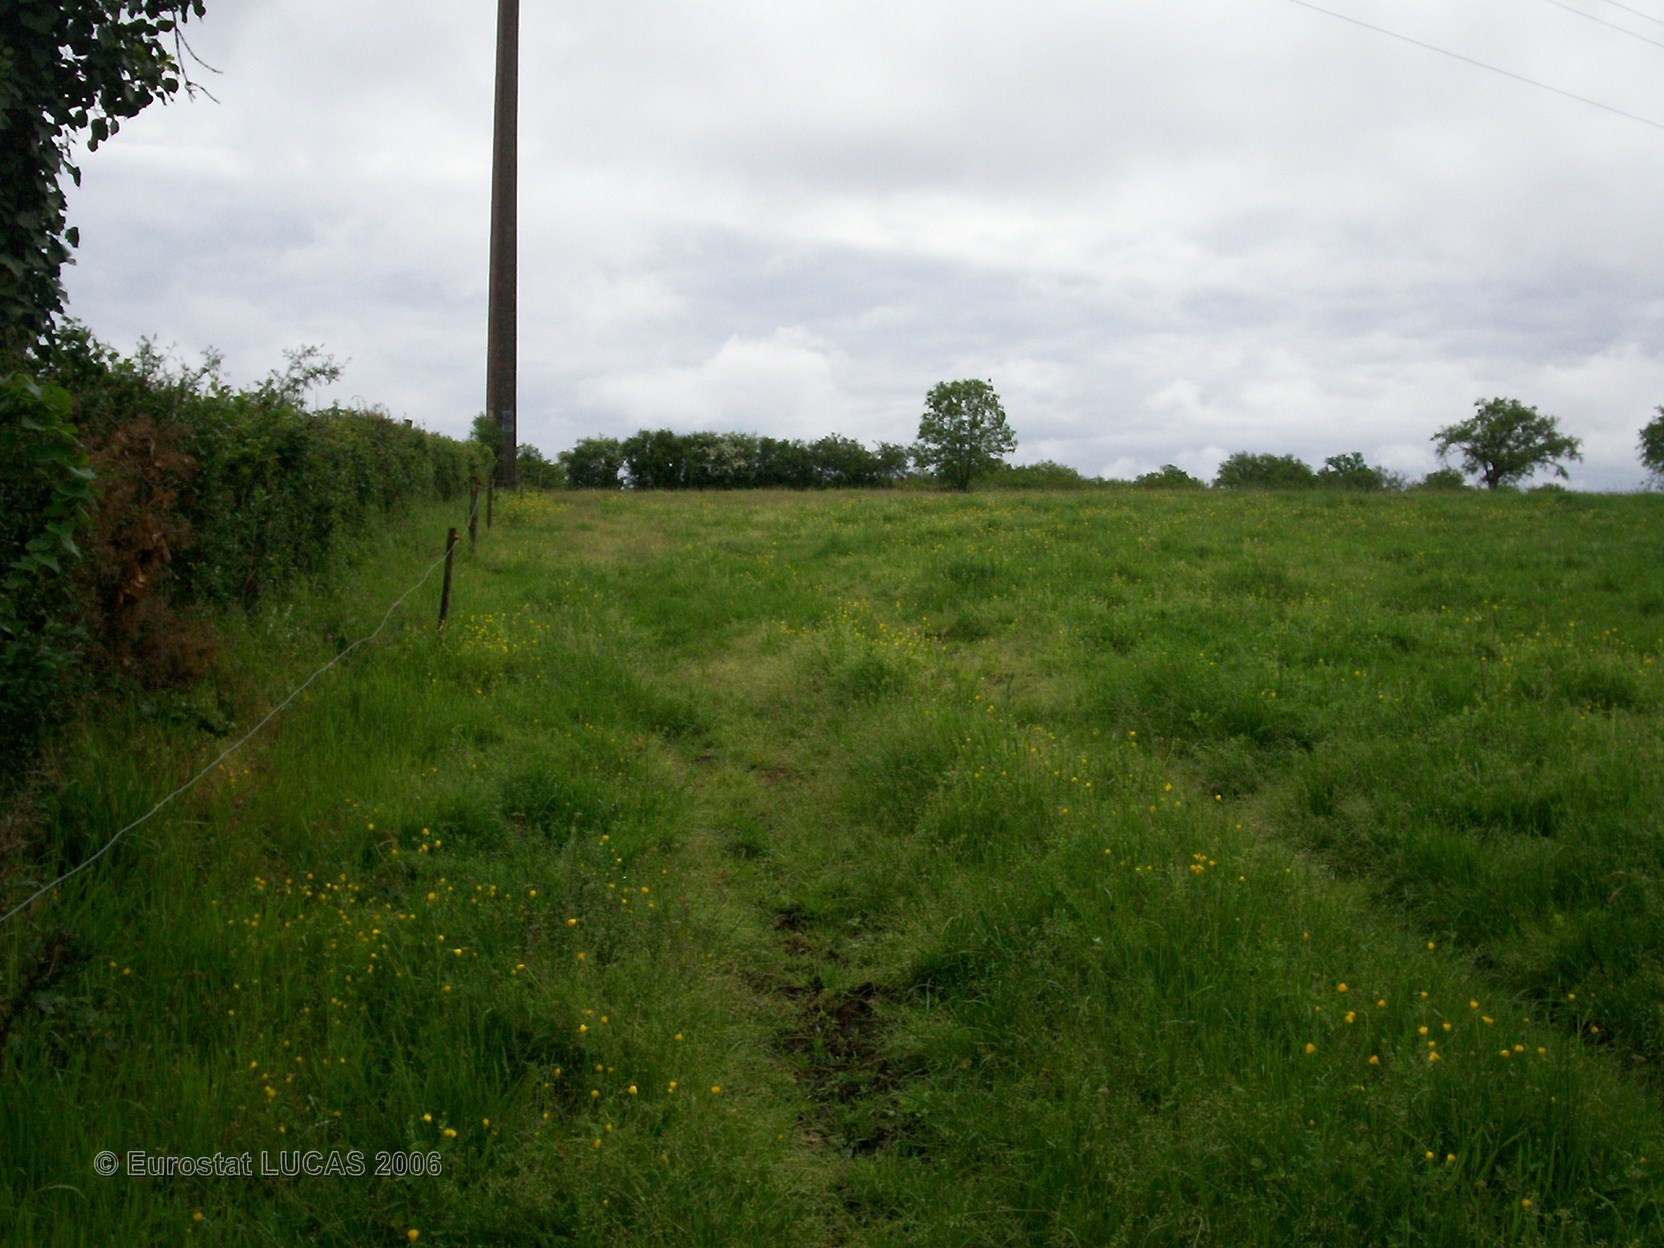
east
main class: Grassland
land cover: Grassland without tree/shrub cover
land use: Agriculture (excluding fallow land and kitchen gardens)
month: May
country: FR
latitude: 46.6885
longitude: -0.2895
